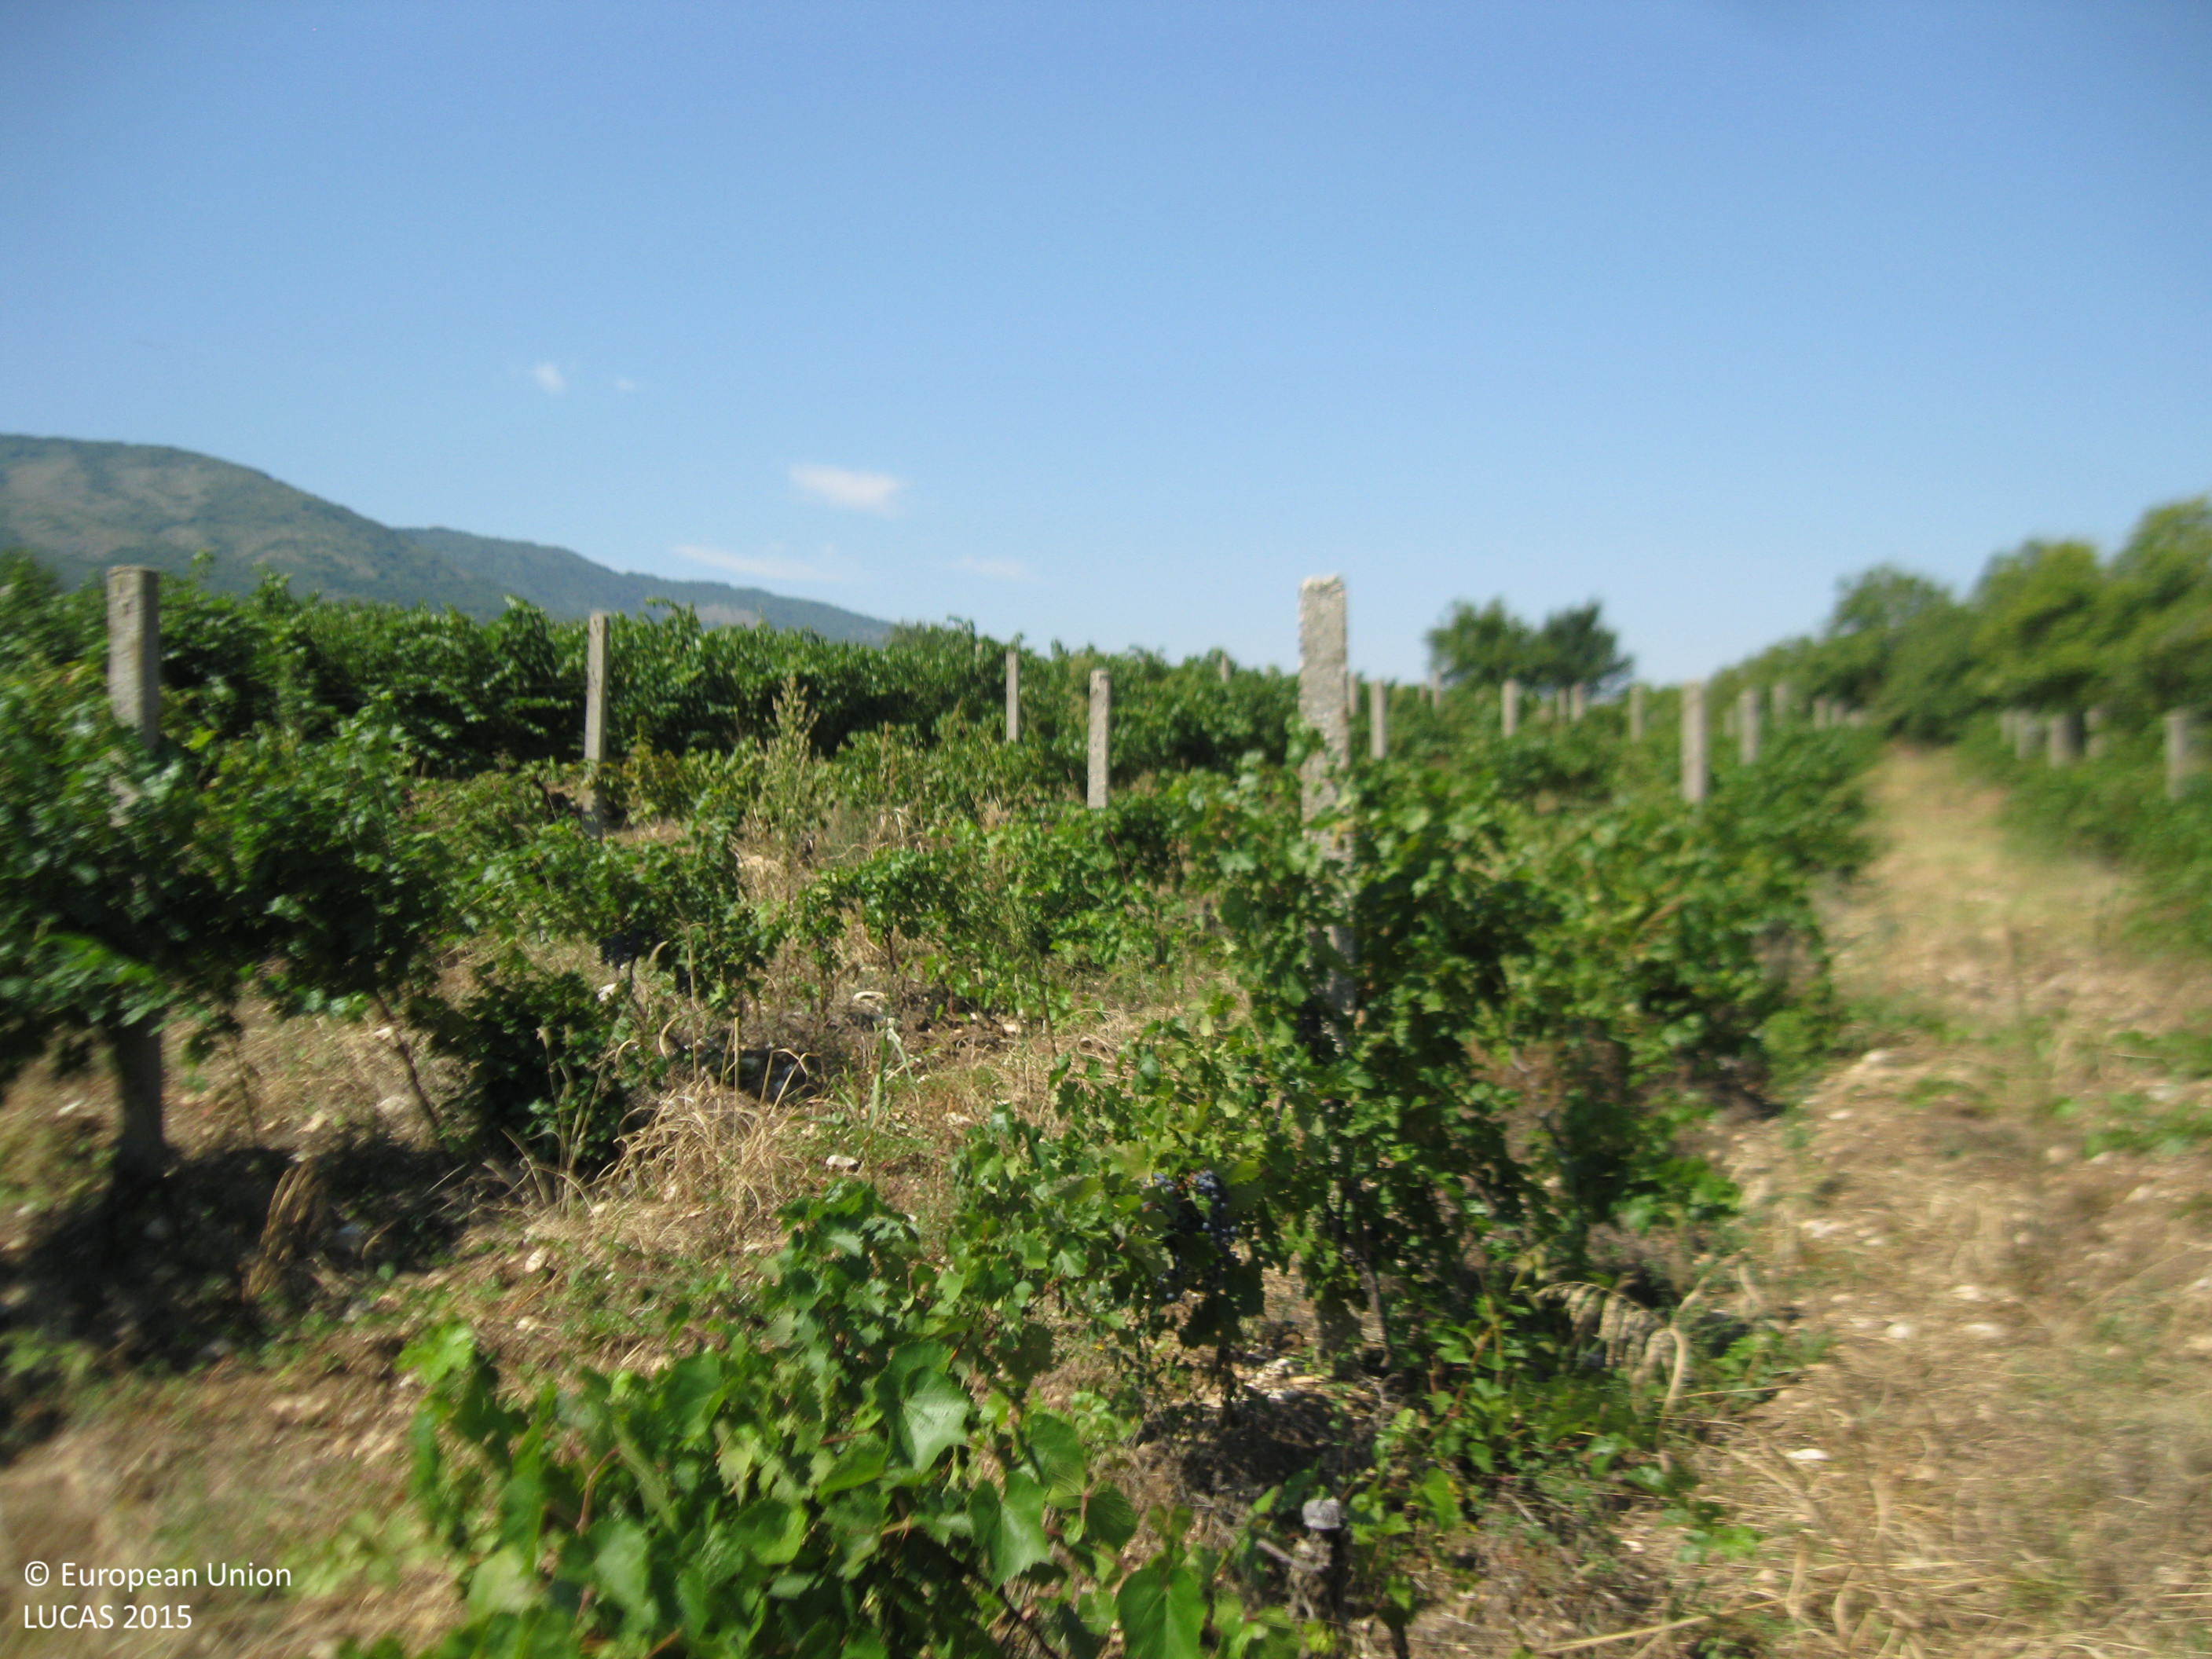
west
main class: Cropland
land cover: Vineyards
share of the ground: 25 - 50 %
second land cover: Spontaneously vegetated surfaces
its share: 50 - 75 %
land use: Agriculture (excluding fallow land and kitchen gardens)
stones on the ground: 10 - 25 %
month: August
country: BG
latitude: 41.9373
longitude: 24.9724
